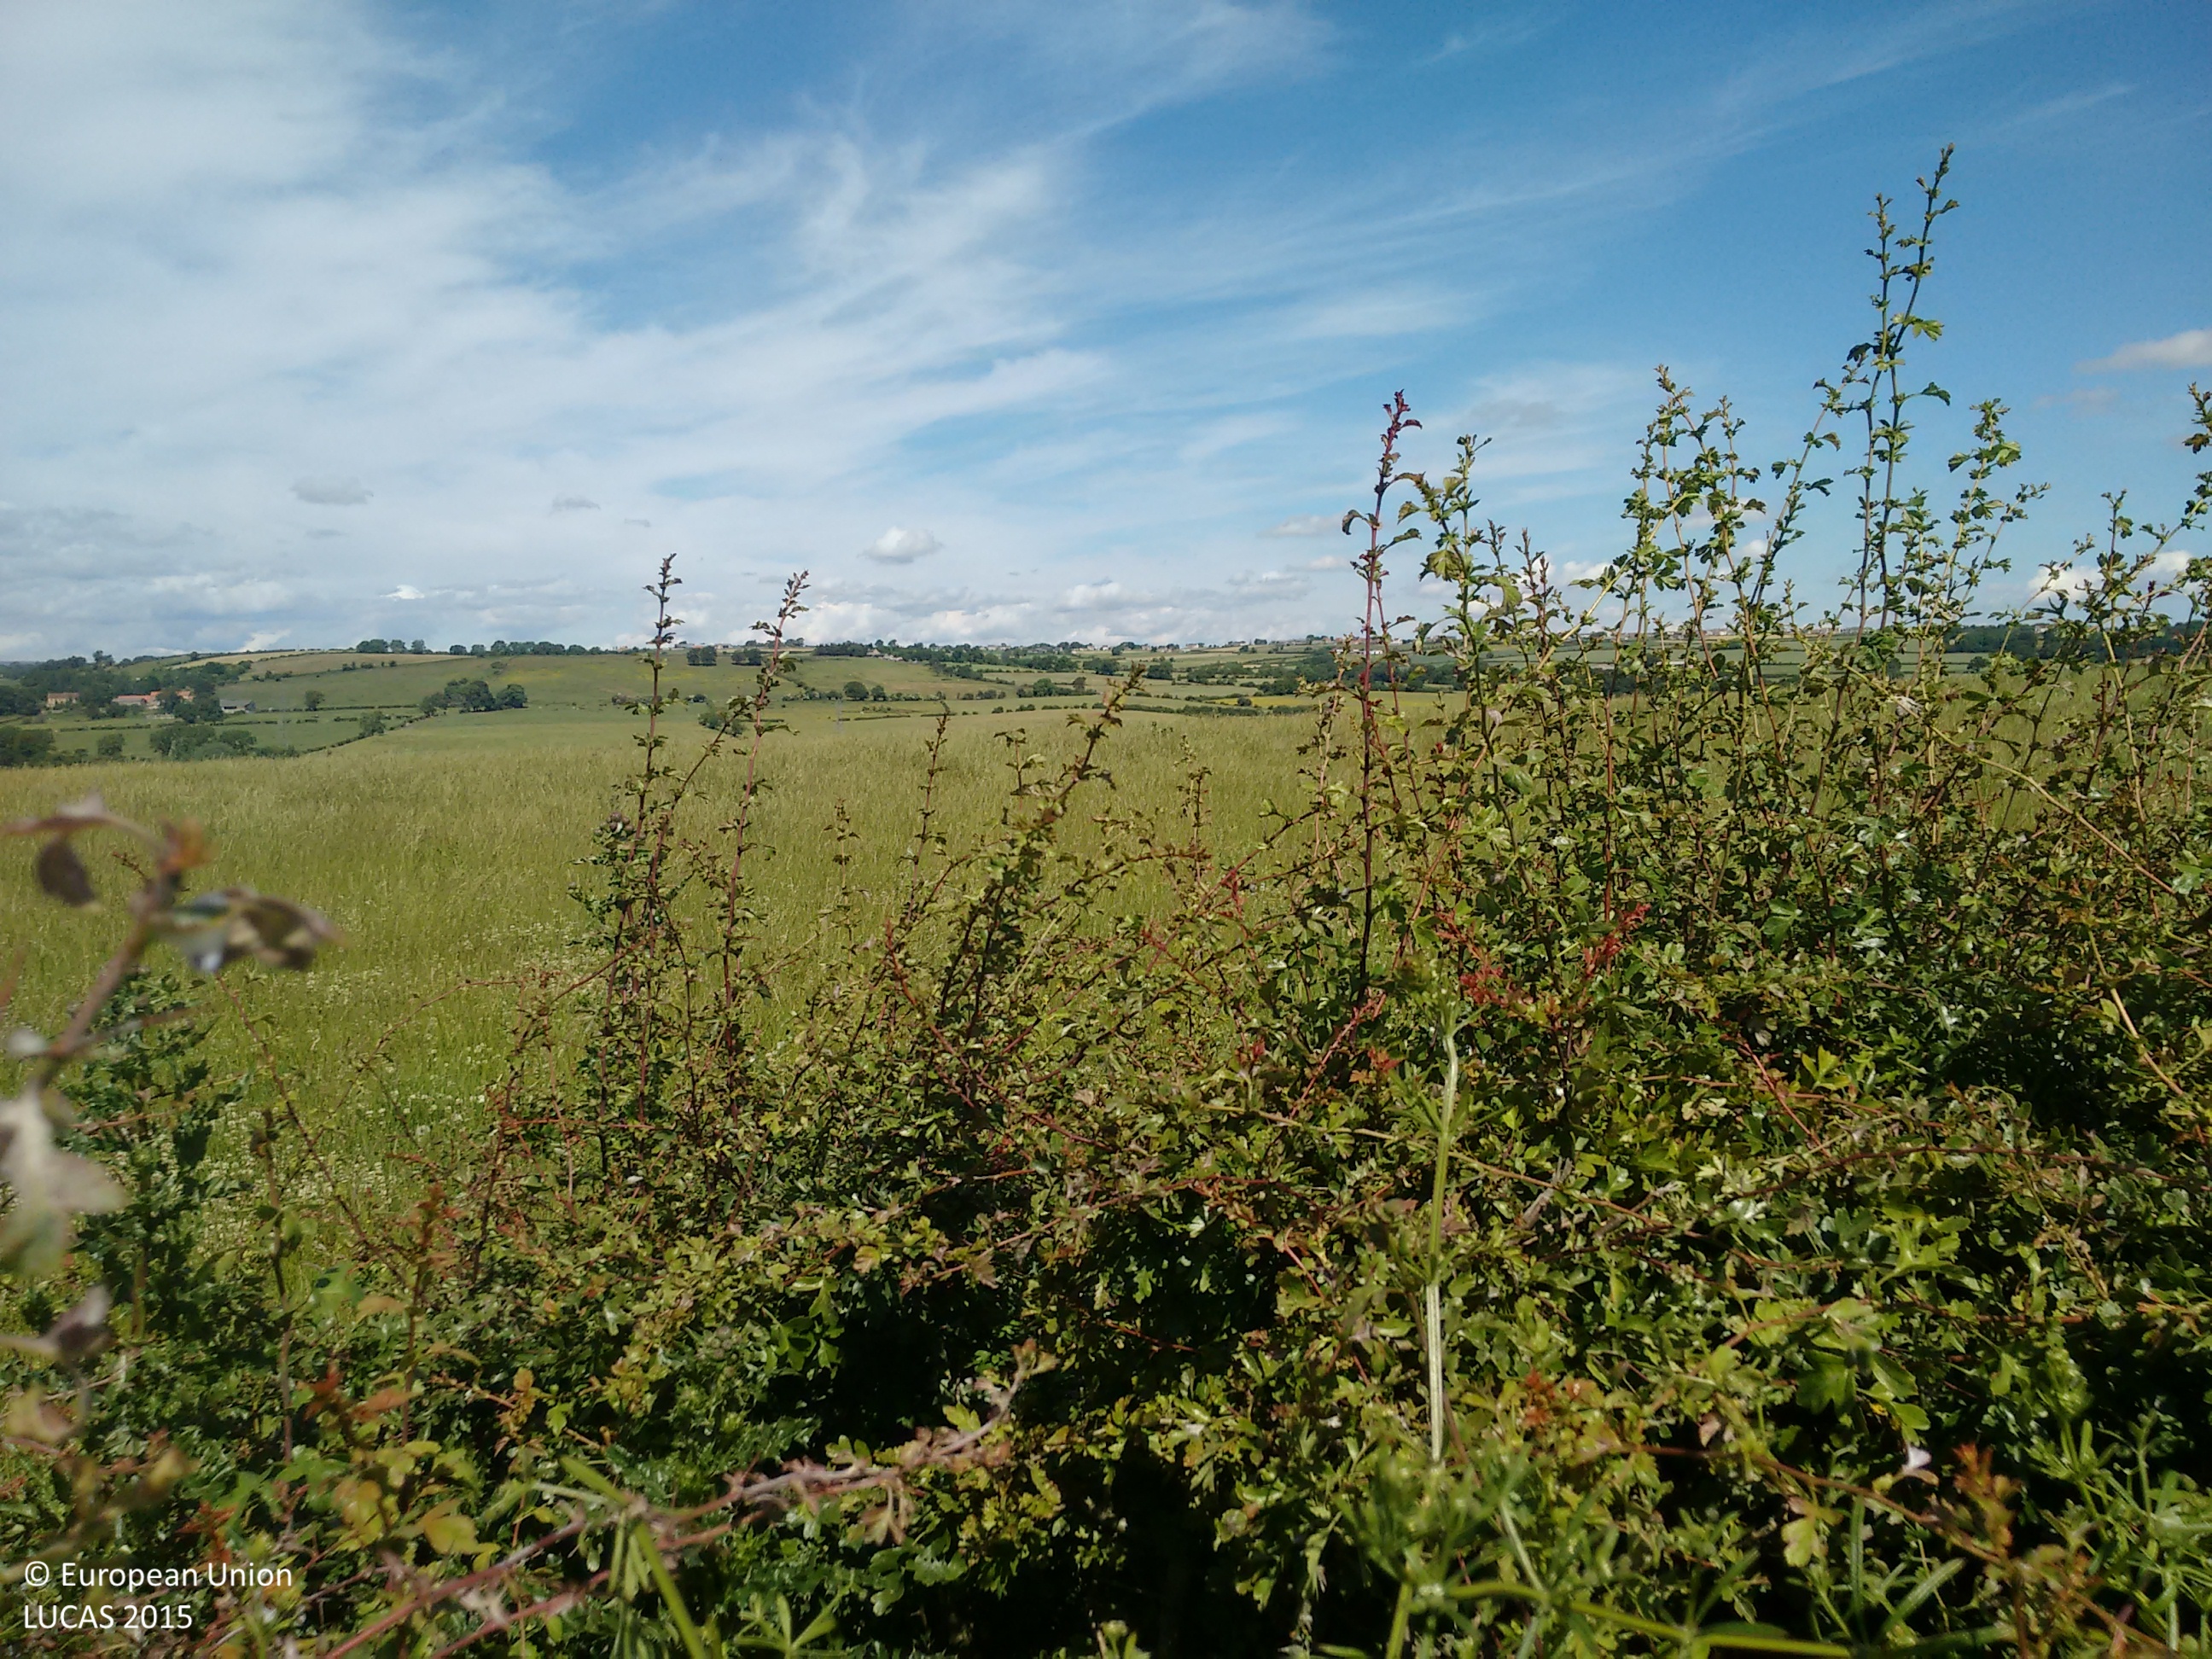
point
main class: Grassland
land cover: Grassland without tree/shrub cover
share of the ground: > 75 %
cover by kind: herbaceous plants 100 %
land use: Agriculture (excluding fallow land and kitchen gardens)
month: July
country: GB
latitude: 54.6277
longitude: -1.7464
